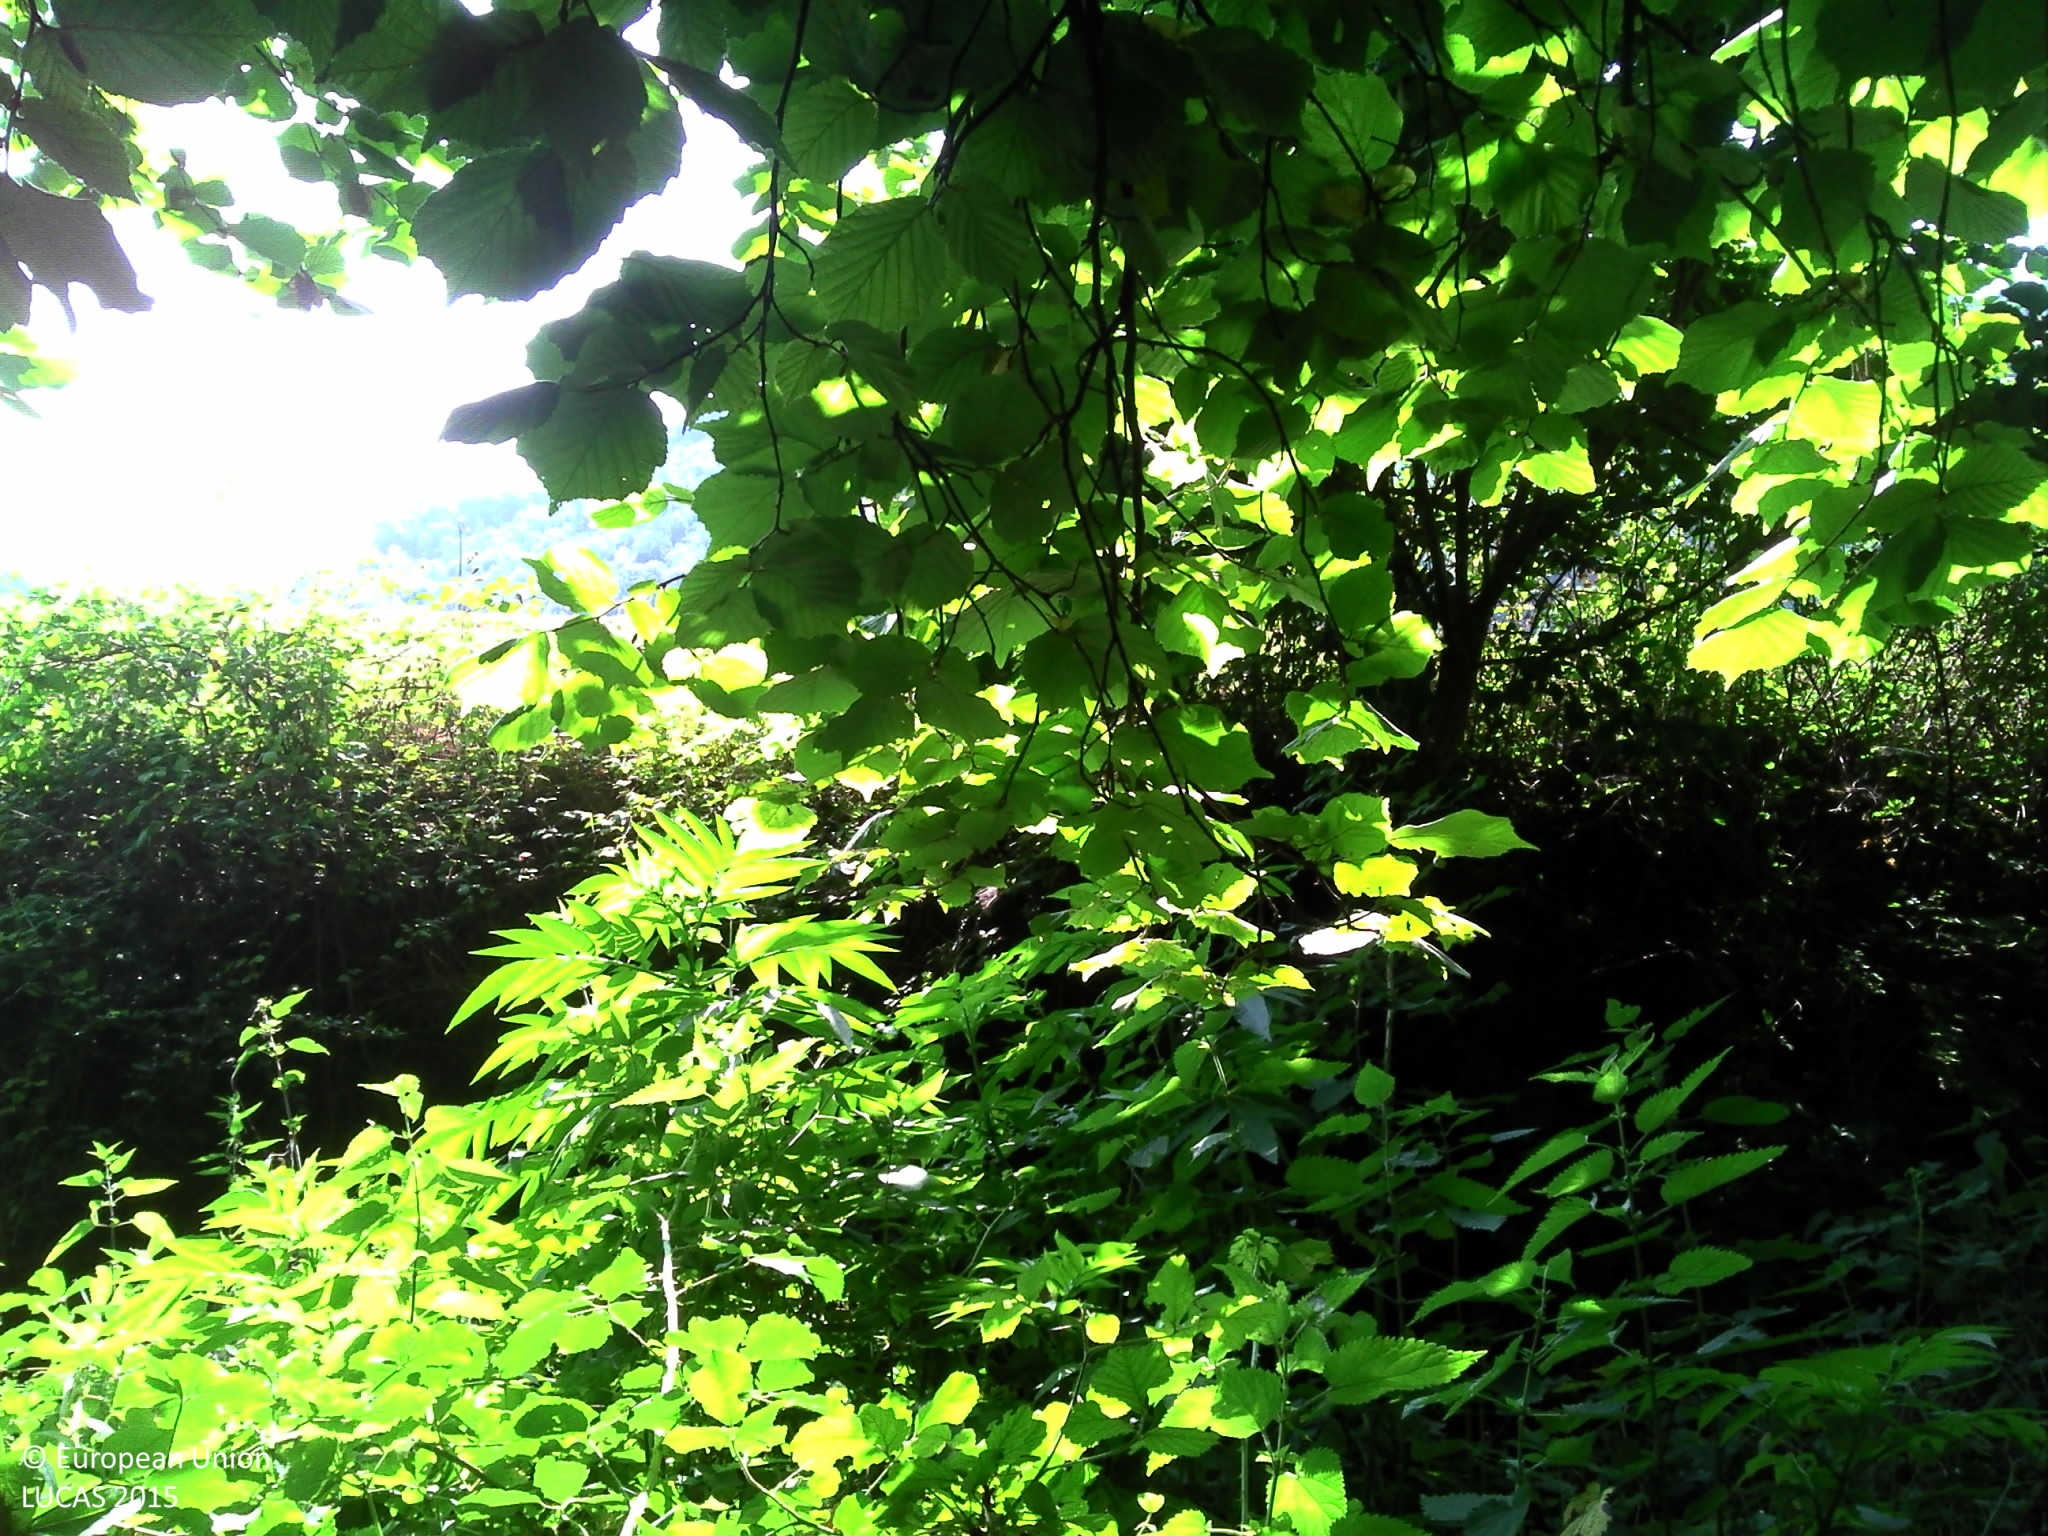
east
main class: Woodland
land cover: Broadleaved woodland
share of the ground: > 75 %
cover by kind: broadleaved forest trees 85 %, unconsolidated bare surface 10 %, herbaceous plants 5 %
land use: Semi-natural and natural areas not in use
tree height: > 5 m
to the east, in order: Broadleaved woodland; Ditches and canals; Broadleaved woodland; Fences; Durum wheat; Electric lines; Temporary grasslands
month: July
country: FR
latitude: 43.0004
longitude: 1.0371
